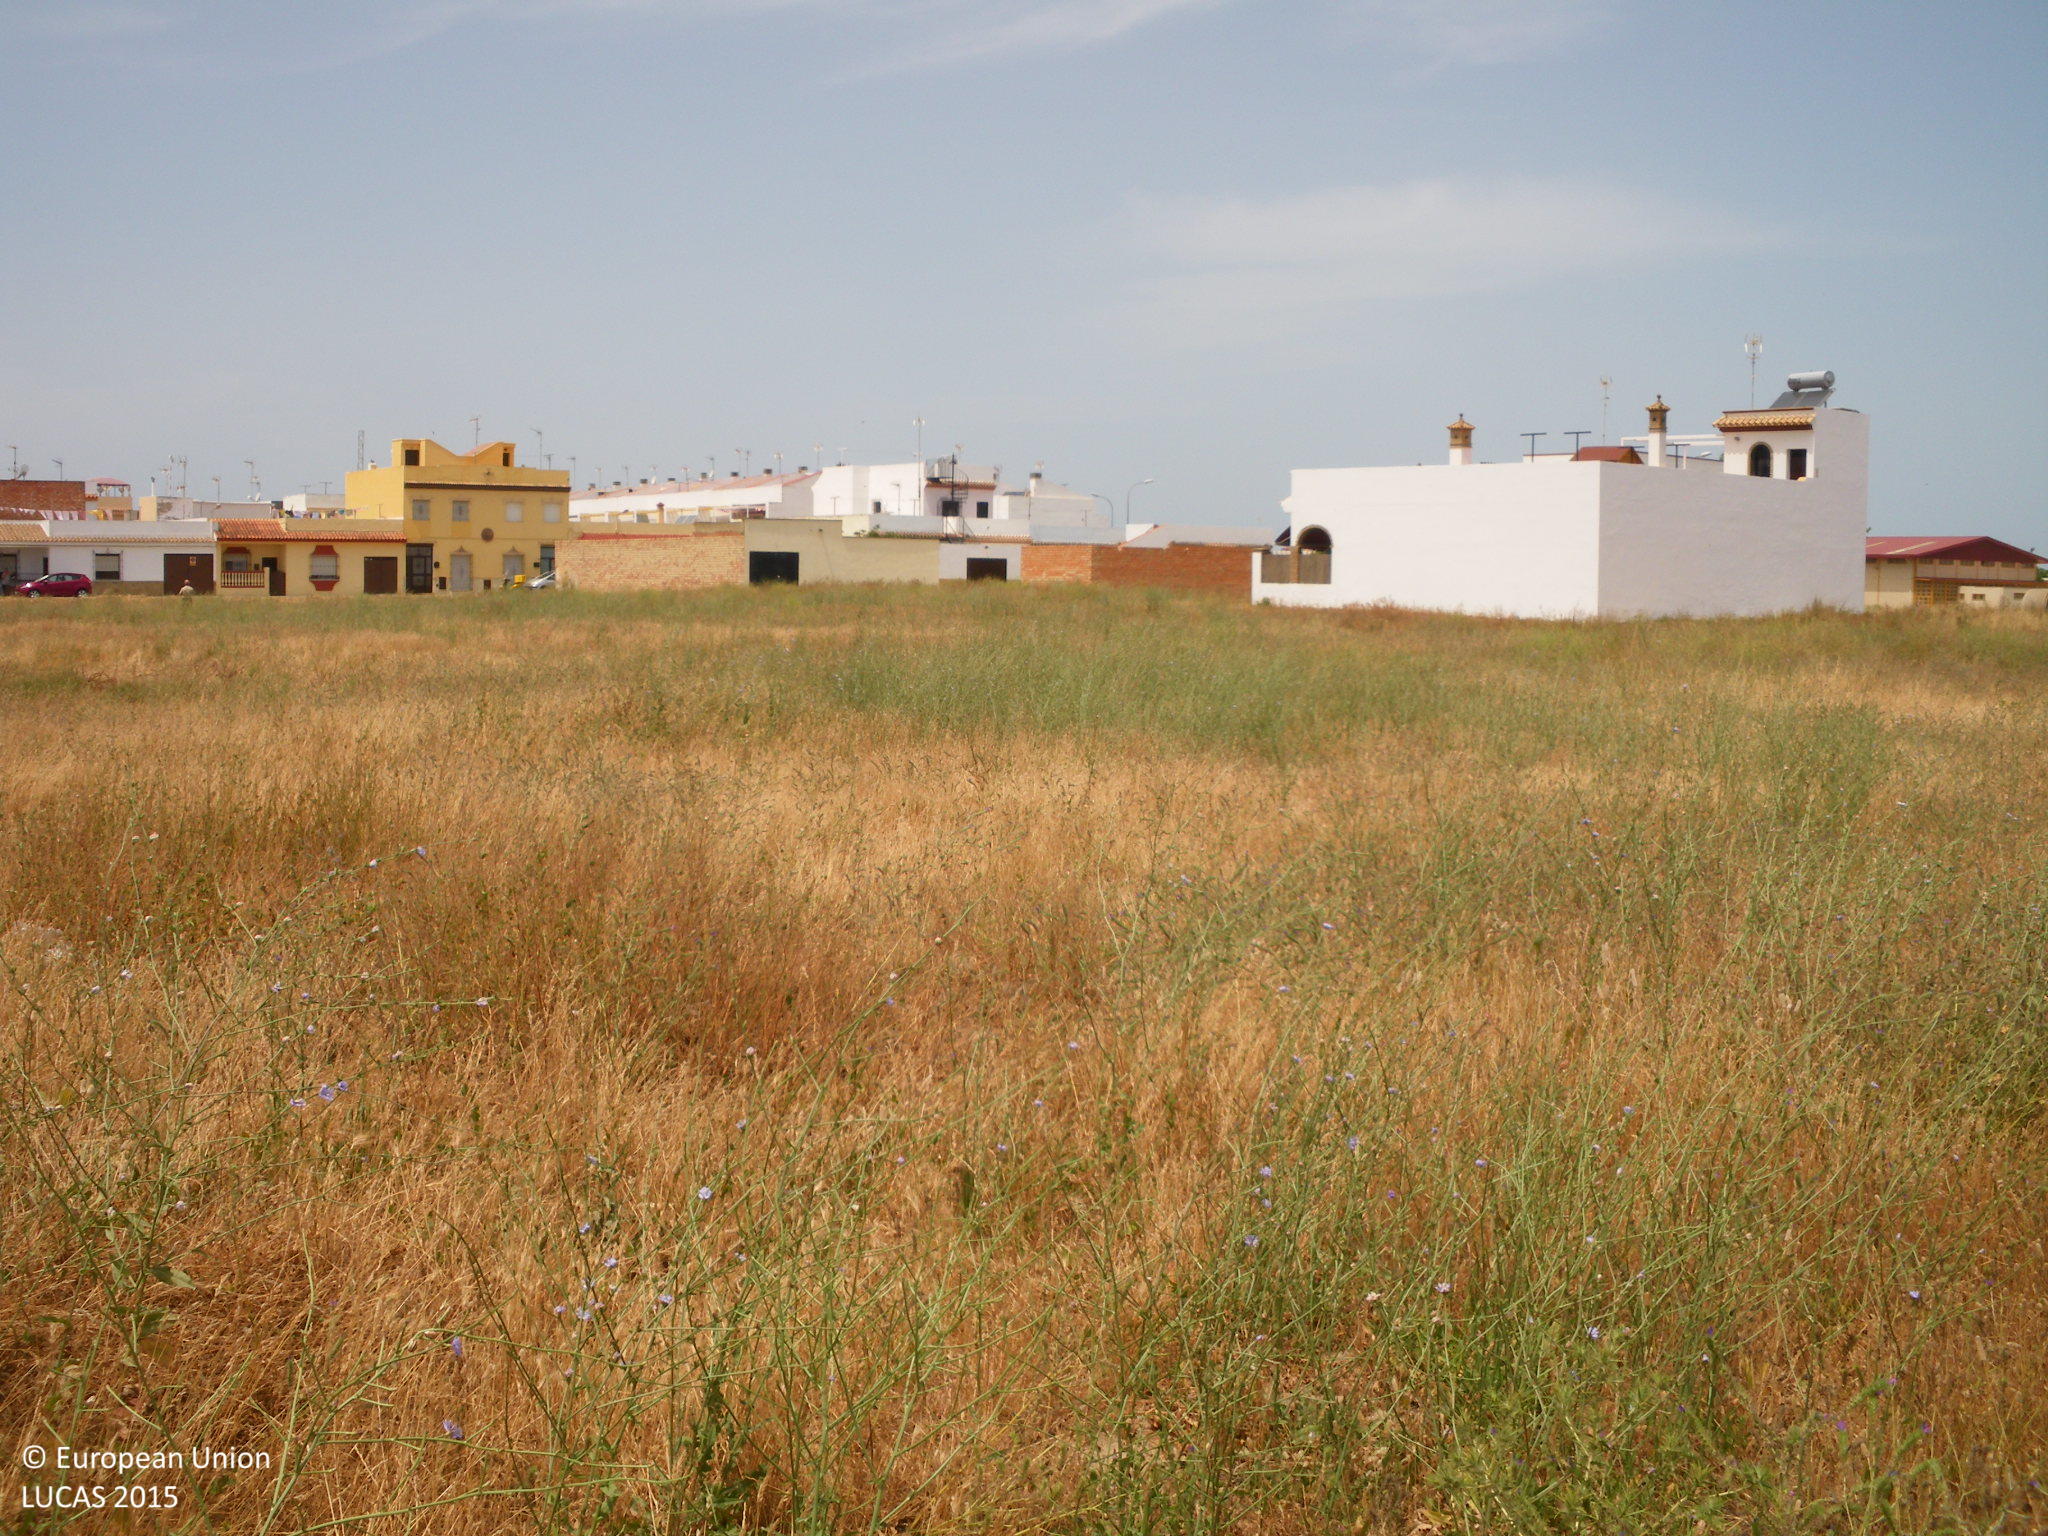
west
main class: Grassland
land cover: Grassland without tree/shrub cover
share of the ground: > 75 %
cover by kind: herbaceous plants 95 %, unconsolidated bare surface 5 %
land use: Agriculture (excluding fallow land and kitchen gardens)
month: June
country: ES
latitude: 36.7337
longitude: -6.4231
